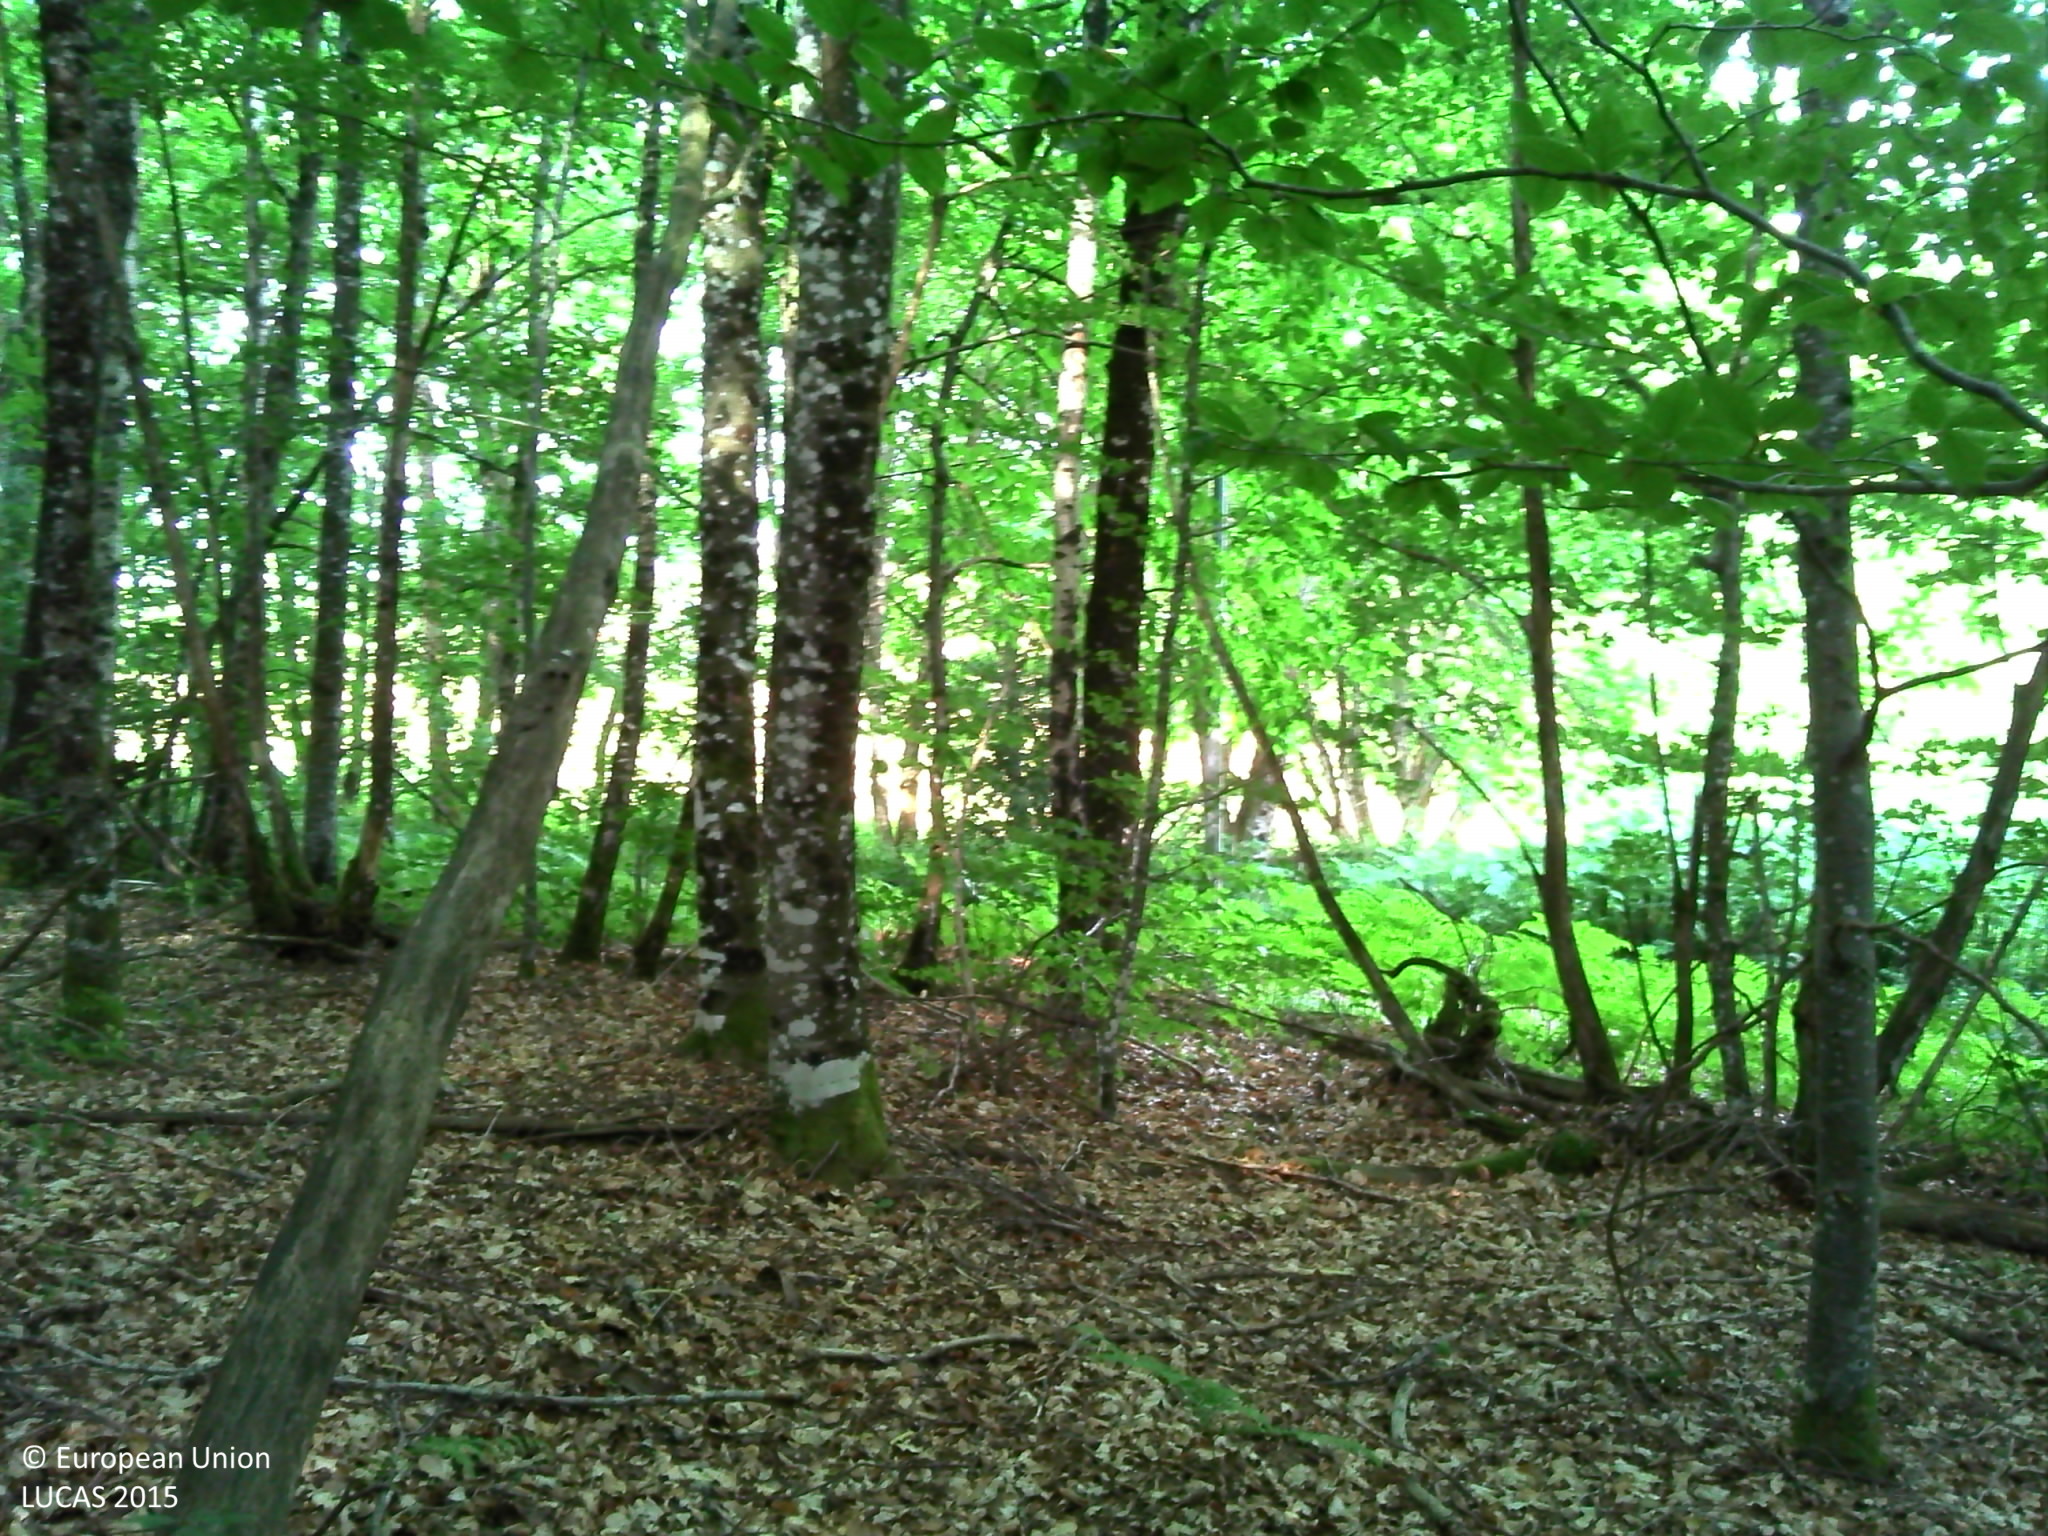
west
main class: Woodland
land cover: Broadleaved woodland
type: beech forest
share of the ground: > 75 %
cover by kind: broadleaved forest trees 85 %, herbaceous plants 10 %, lichens and mosses 5 %
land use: Forestry
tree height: > 5 m
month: July
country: FR
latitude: 44.5900
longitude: 2.5579
